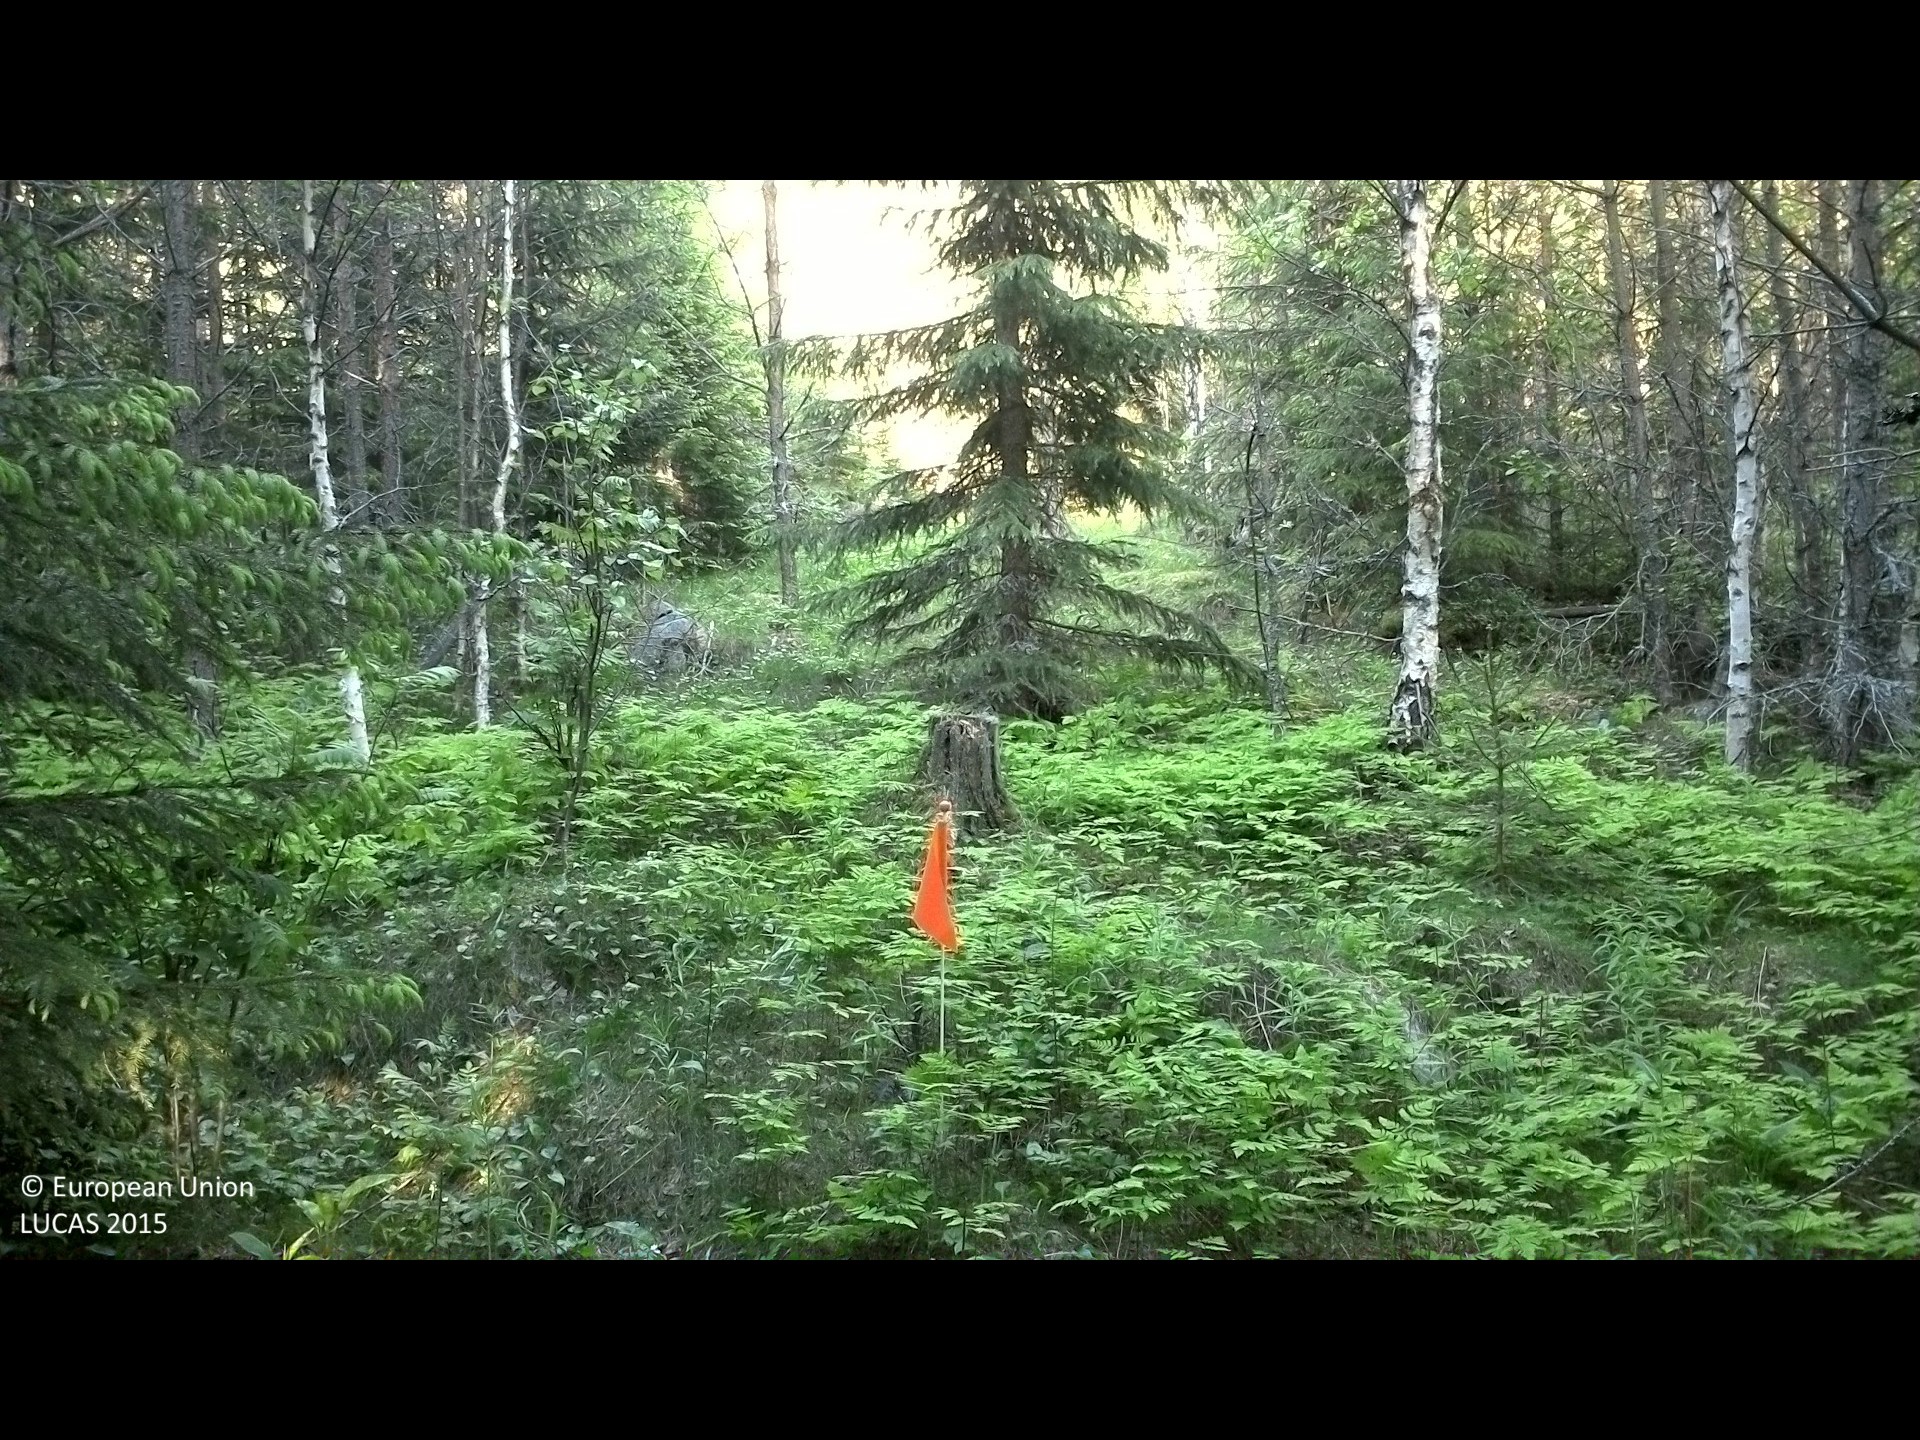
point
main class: Woodland
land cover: Pine dominated mixed woodland
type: boreal forest
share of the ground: 50 - 75 %
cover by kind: coniferous forest trees 40 %, herbaceous plants 40 %, broadleaved forest trees 20 %
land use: Forestry
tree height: > 5 m
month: June
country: SE
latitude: 62.2099
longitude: 17.4608
